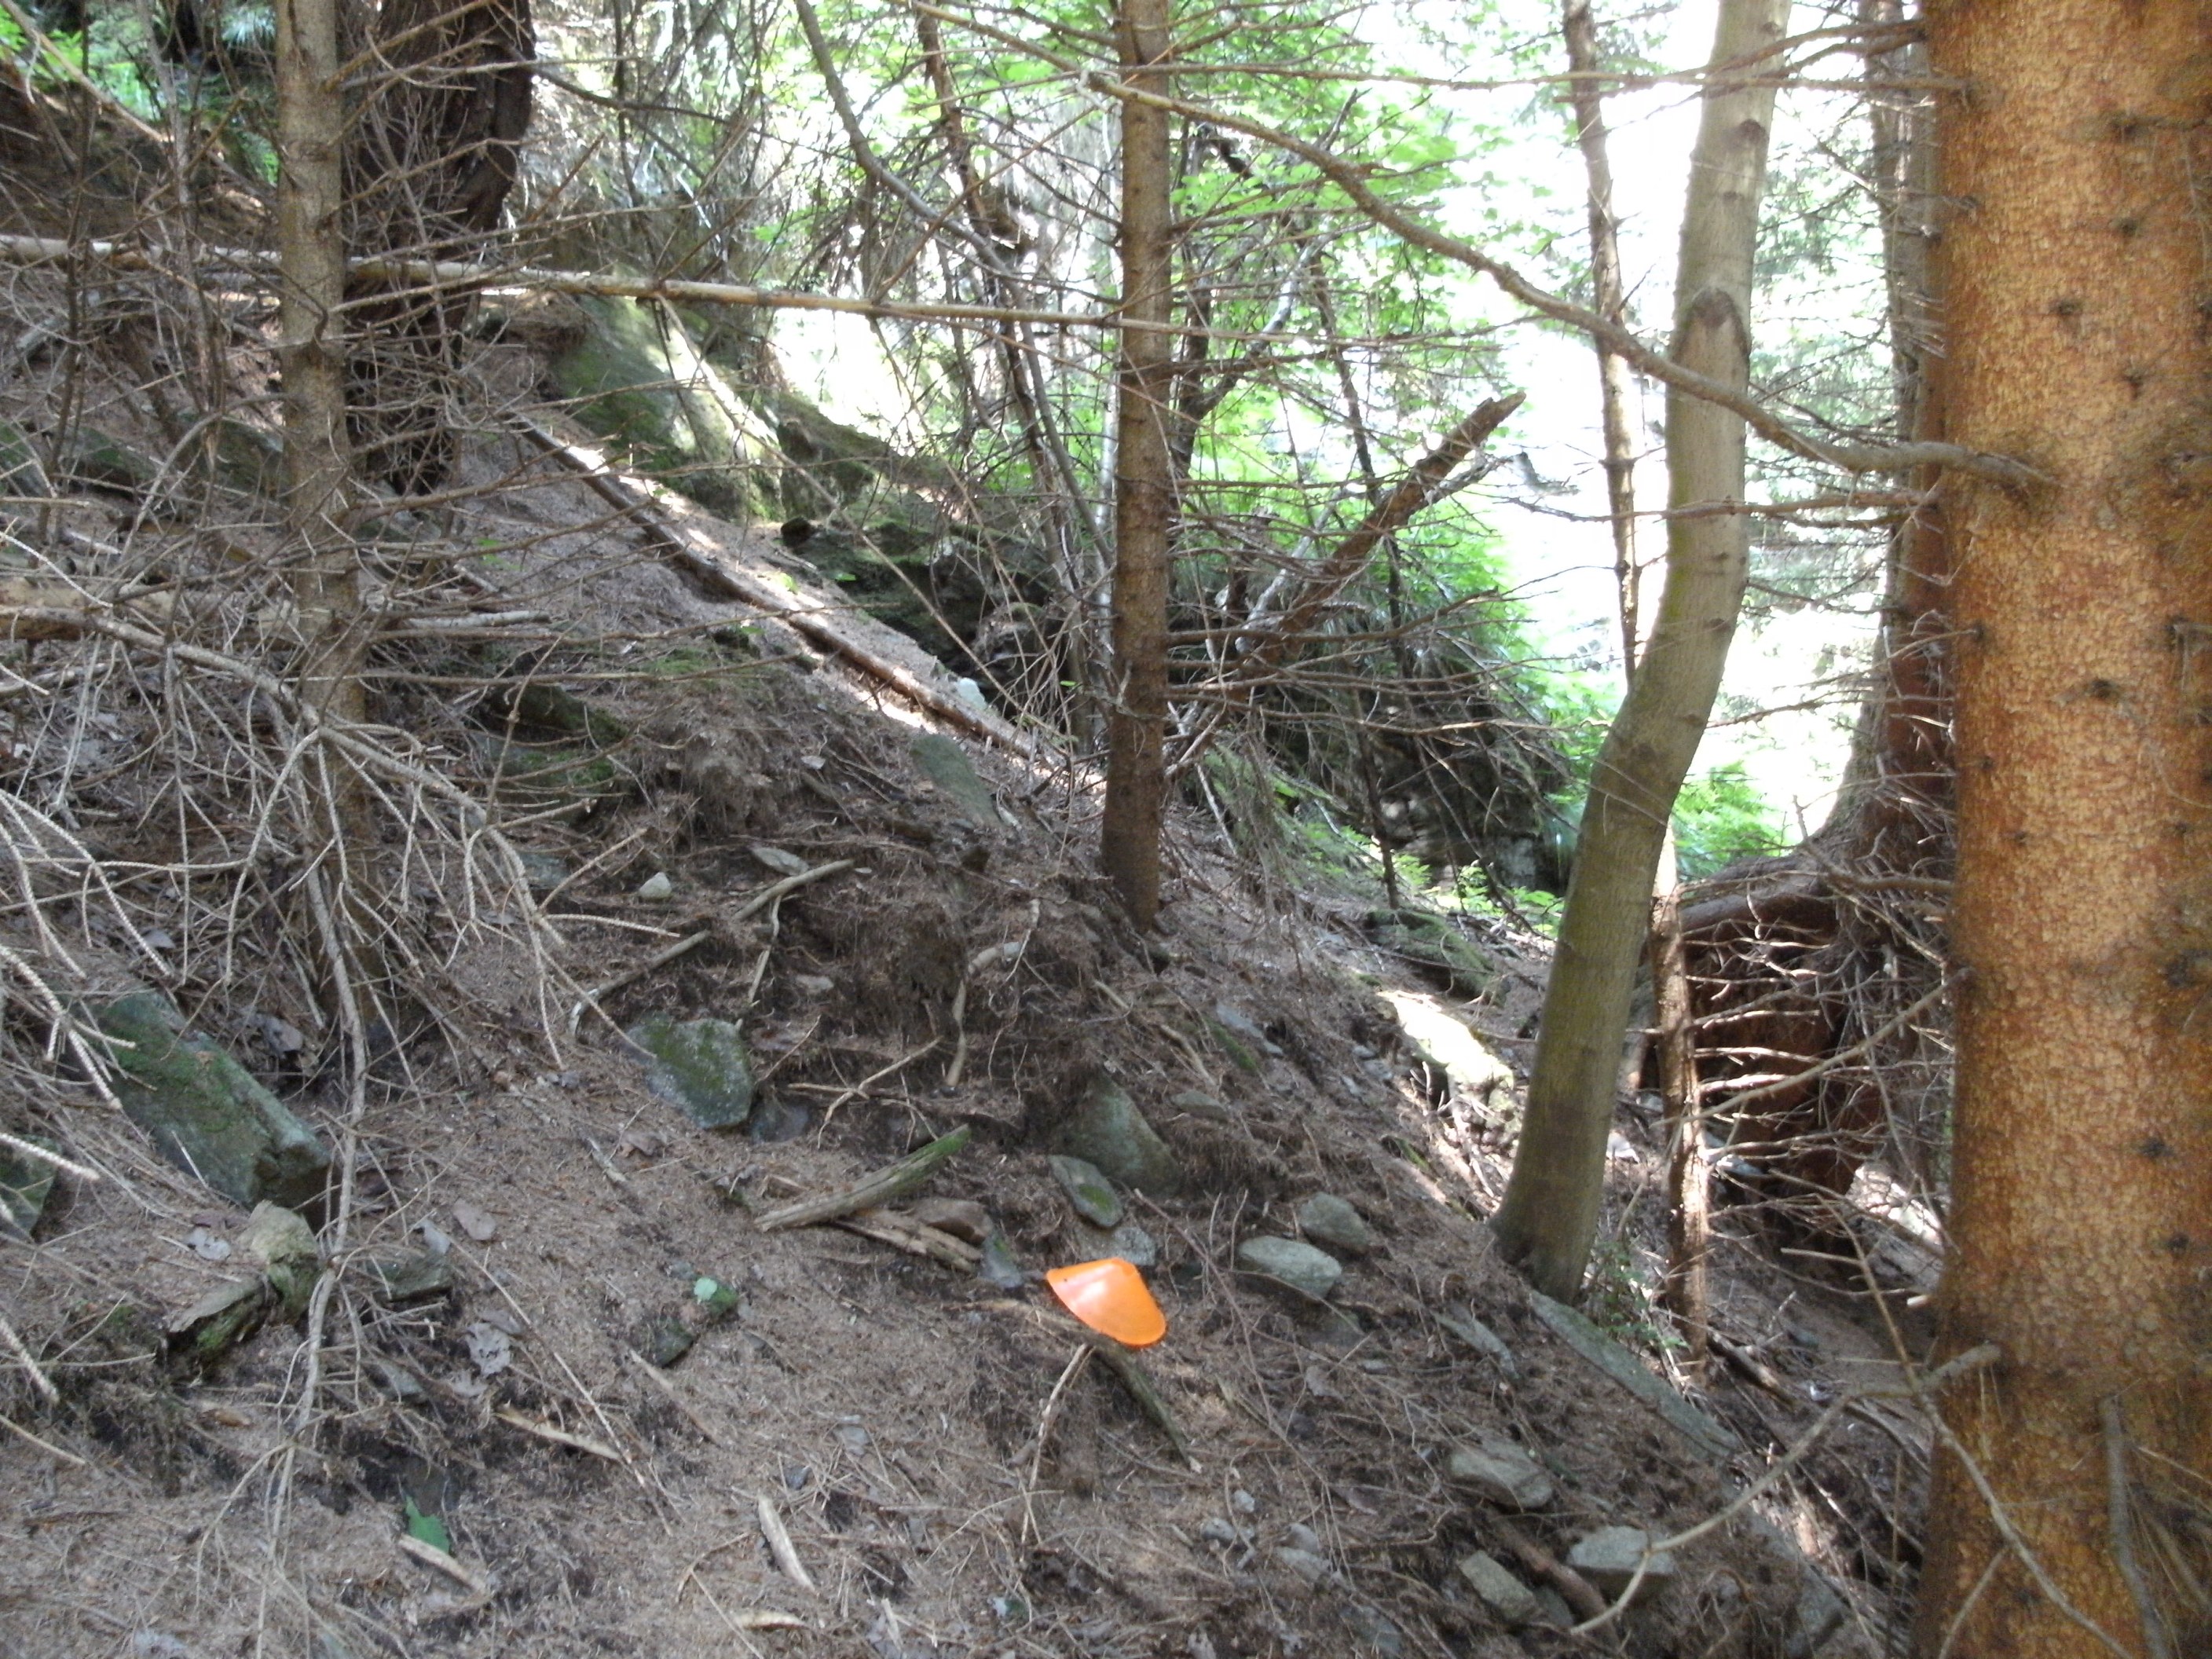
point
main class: Woodland
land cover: Spruce dominated coniferous woodland
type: alpine coniferous forest
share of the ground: > 75 %
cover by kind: coniferous forest trees 85 %, lichens and mosses 5 %, unconsolidated bare surface 5 %
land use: Forestry
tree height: > 5 m
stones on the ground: 10 - 25 %
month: July
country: AT
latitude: 46.7785
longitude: 14.9360
